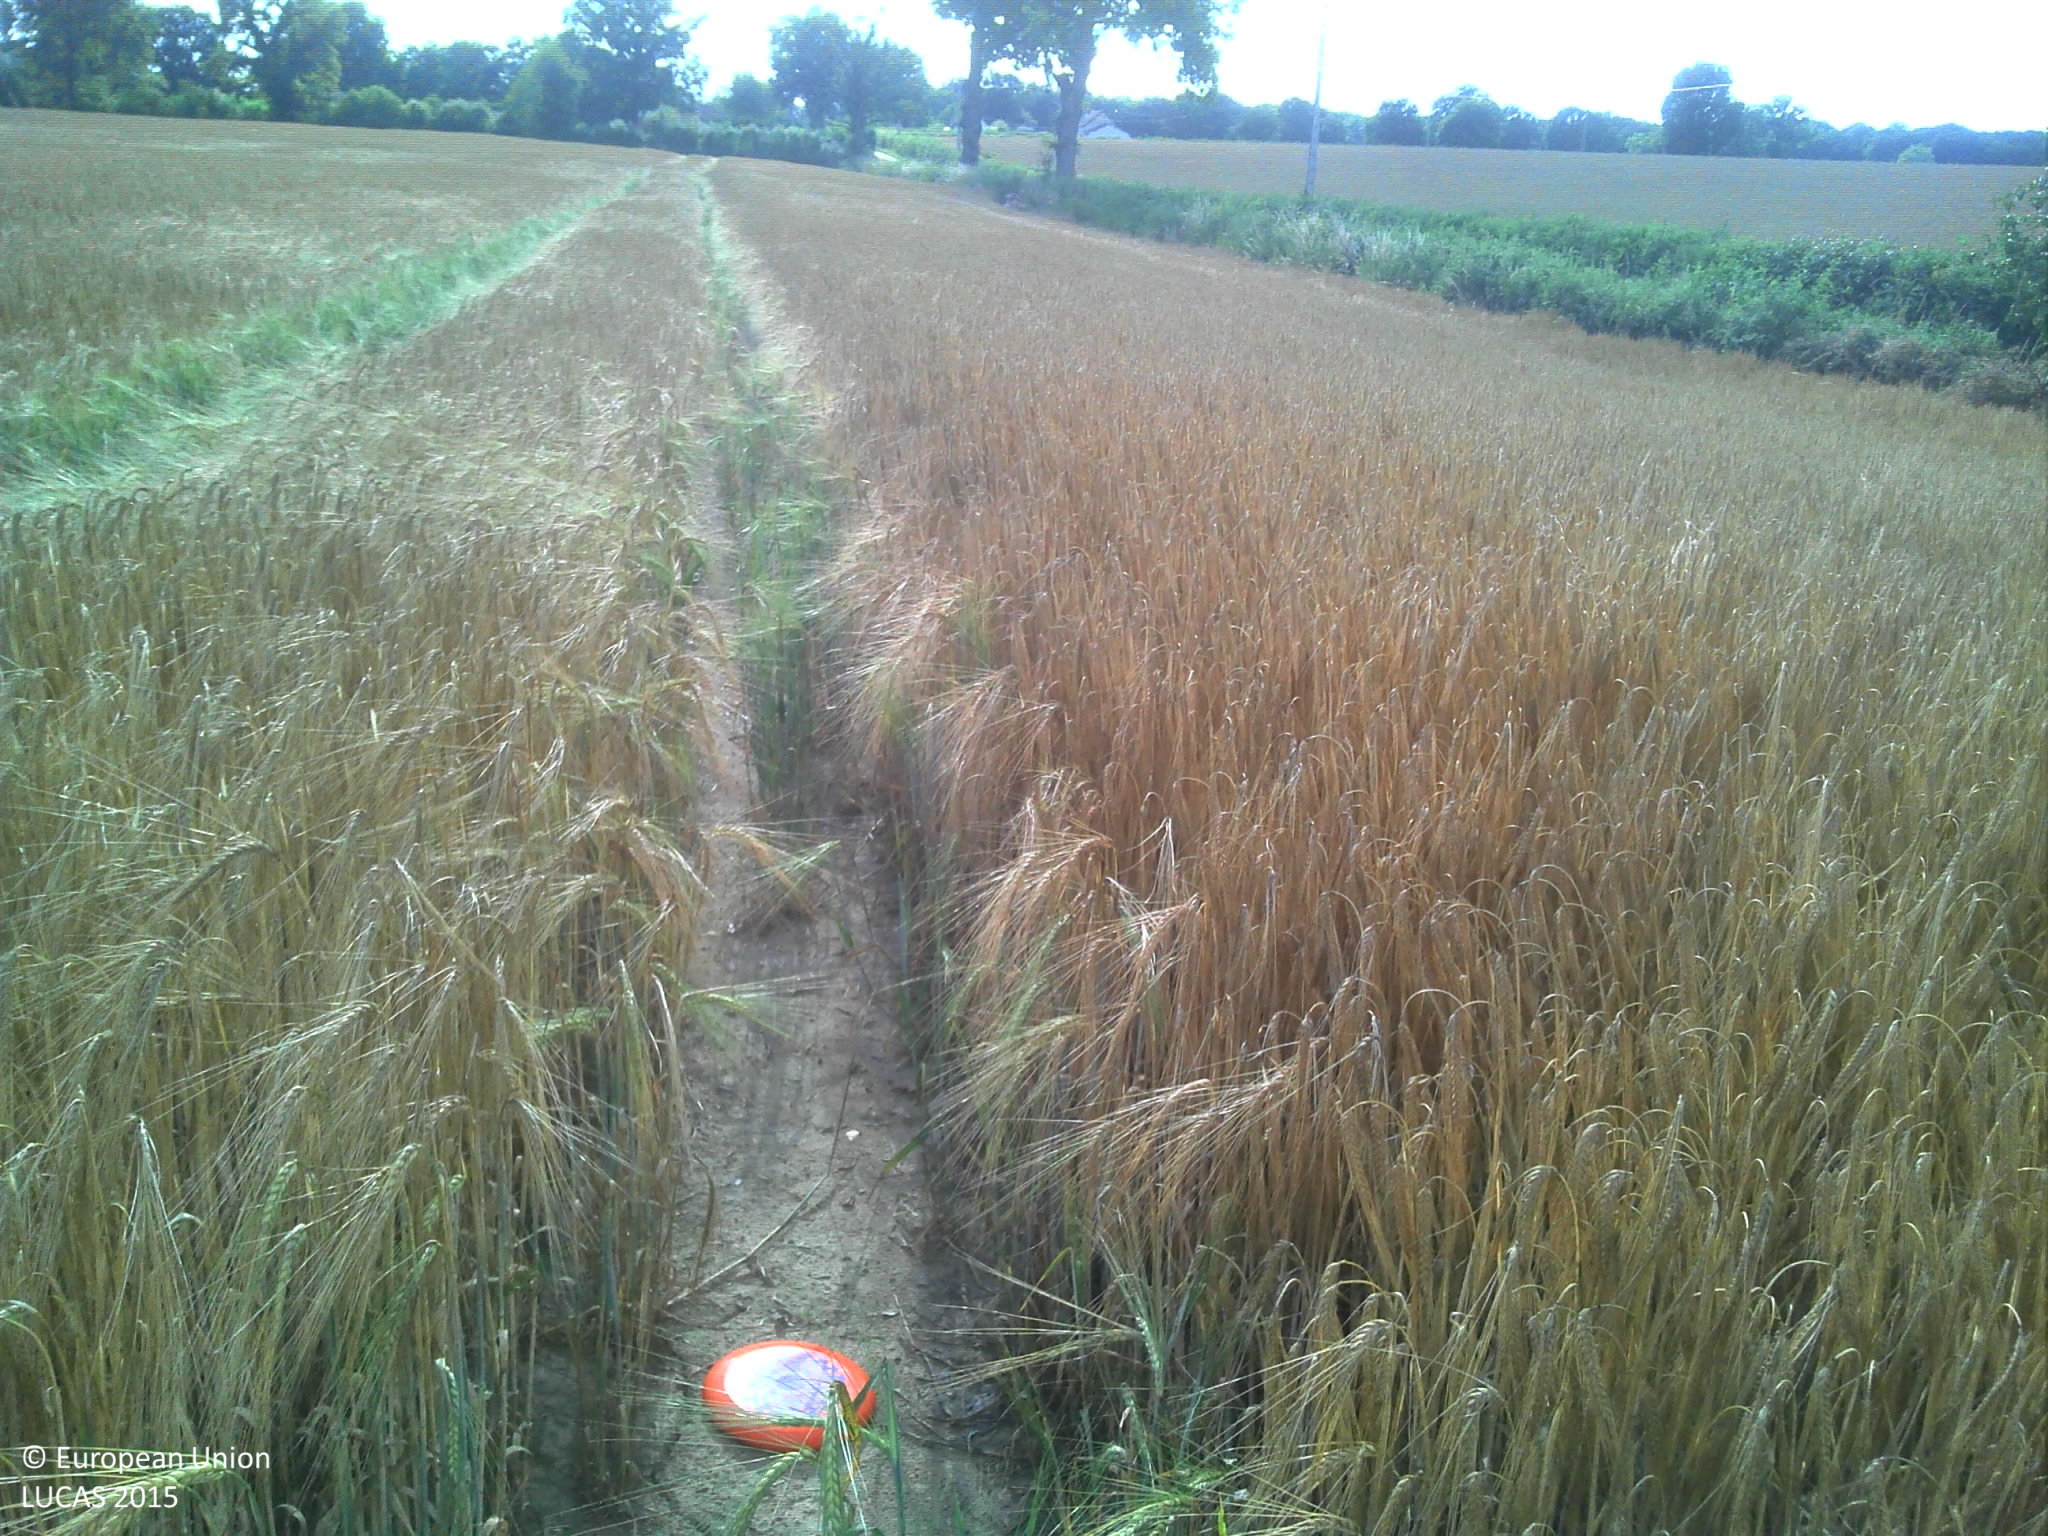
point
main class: Cropland
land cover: Barley
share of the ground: > 75 %
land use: Agriculture (excluding fallow land and kitchen gardens)
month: June
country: FR
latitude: 46.4220
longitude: 4.0803
